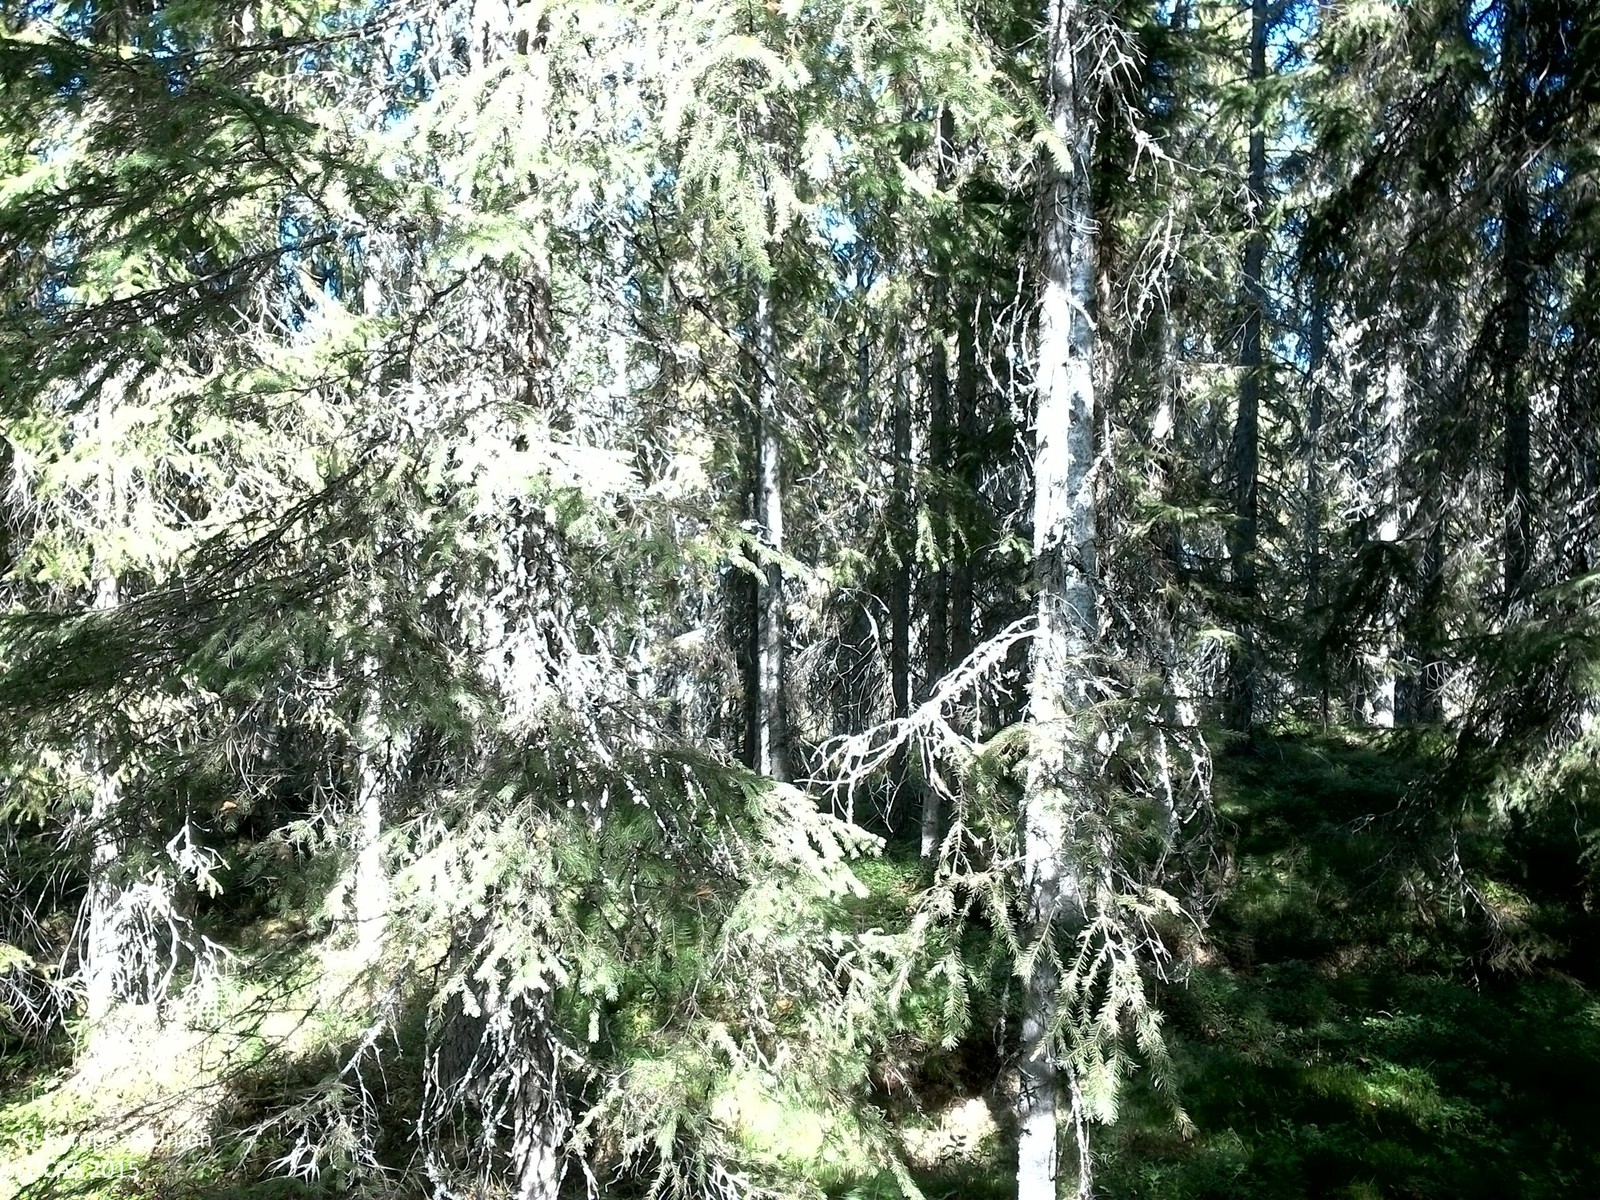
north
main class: Woodland
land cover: Spruce dominated coniferous woodland
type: boreal forest
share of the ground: > 75 %
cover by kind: coniferous forest trees 75 %, shrubs 15 %, broadleaved forest trees 5 %, lichens and mosses 5 %
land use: Forestry
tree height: > 5 m
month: August
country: SE
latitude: 63.7212
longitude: 17.3211
